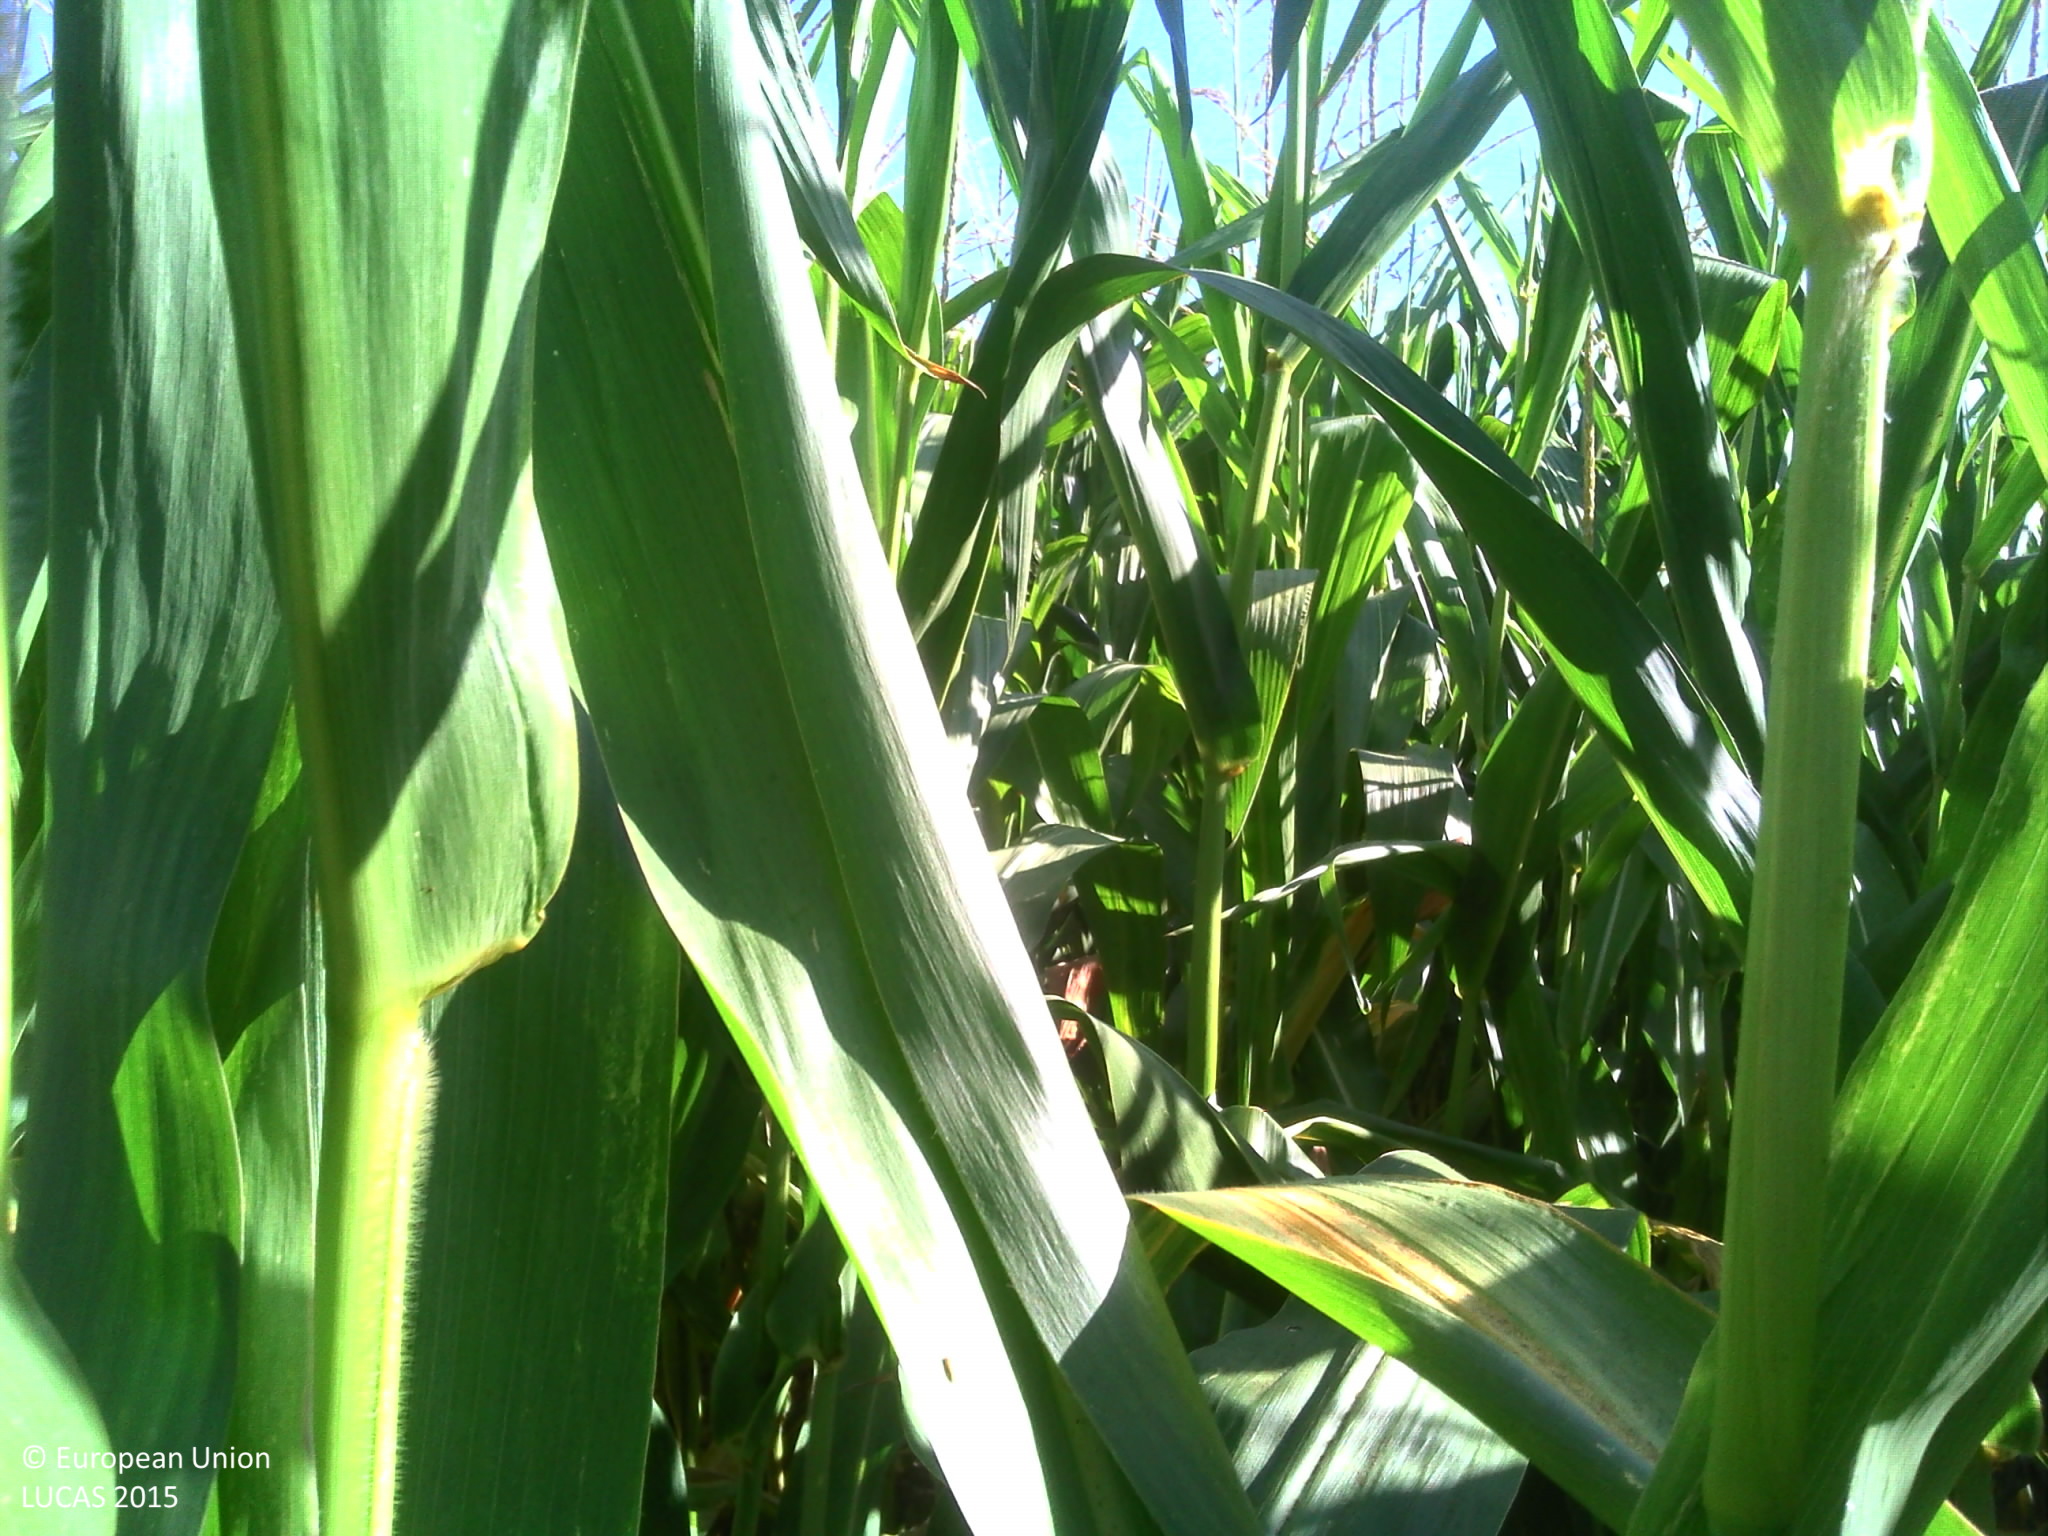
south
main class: Cropland
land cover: Maize
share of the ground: > 75 %
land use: Agriculture (excluding fallow land and kitchen gardens)
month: August
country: FR
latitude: 46.7438
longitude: -1.3591
